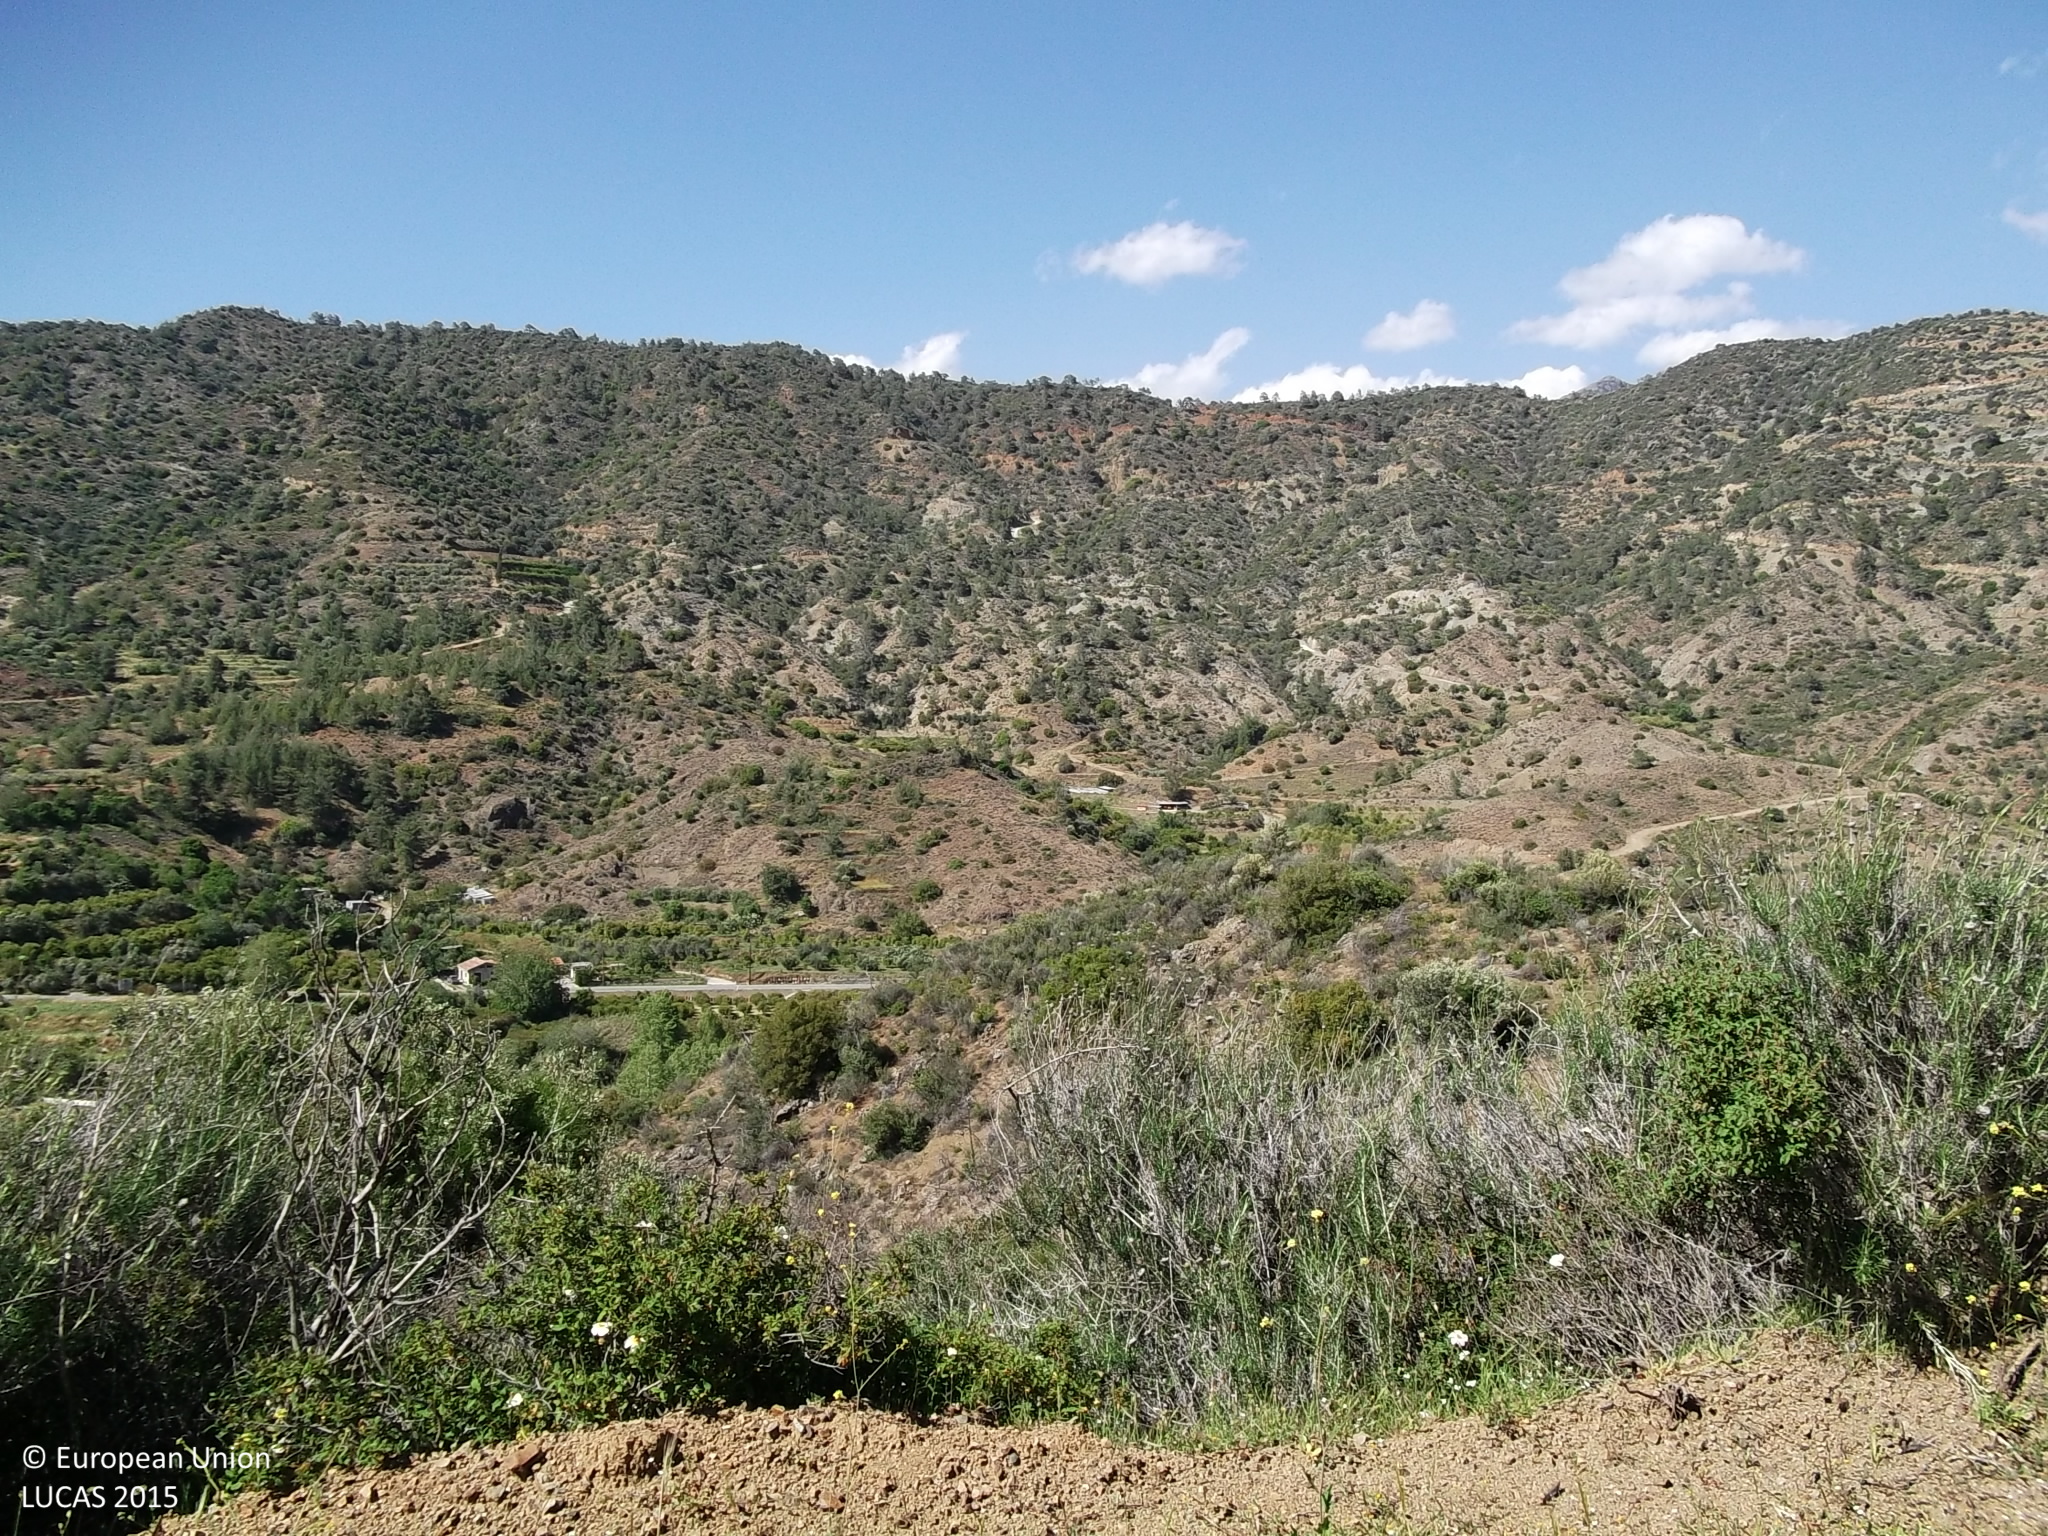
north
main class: Shrubland
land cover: Shrubland with sparse tree cover
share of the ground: > 75 %
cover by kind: shrubs 85 %, unconsolidated bare surface 10 %, coniferous forest trees 5 %
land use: Semi-natural and natural areas not in use
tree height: > 5 m
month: April
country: CY
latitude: 34.8421
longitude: 33.1050
